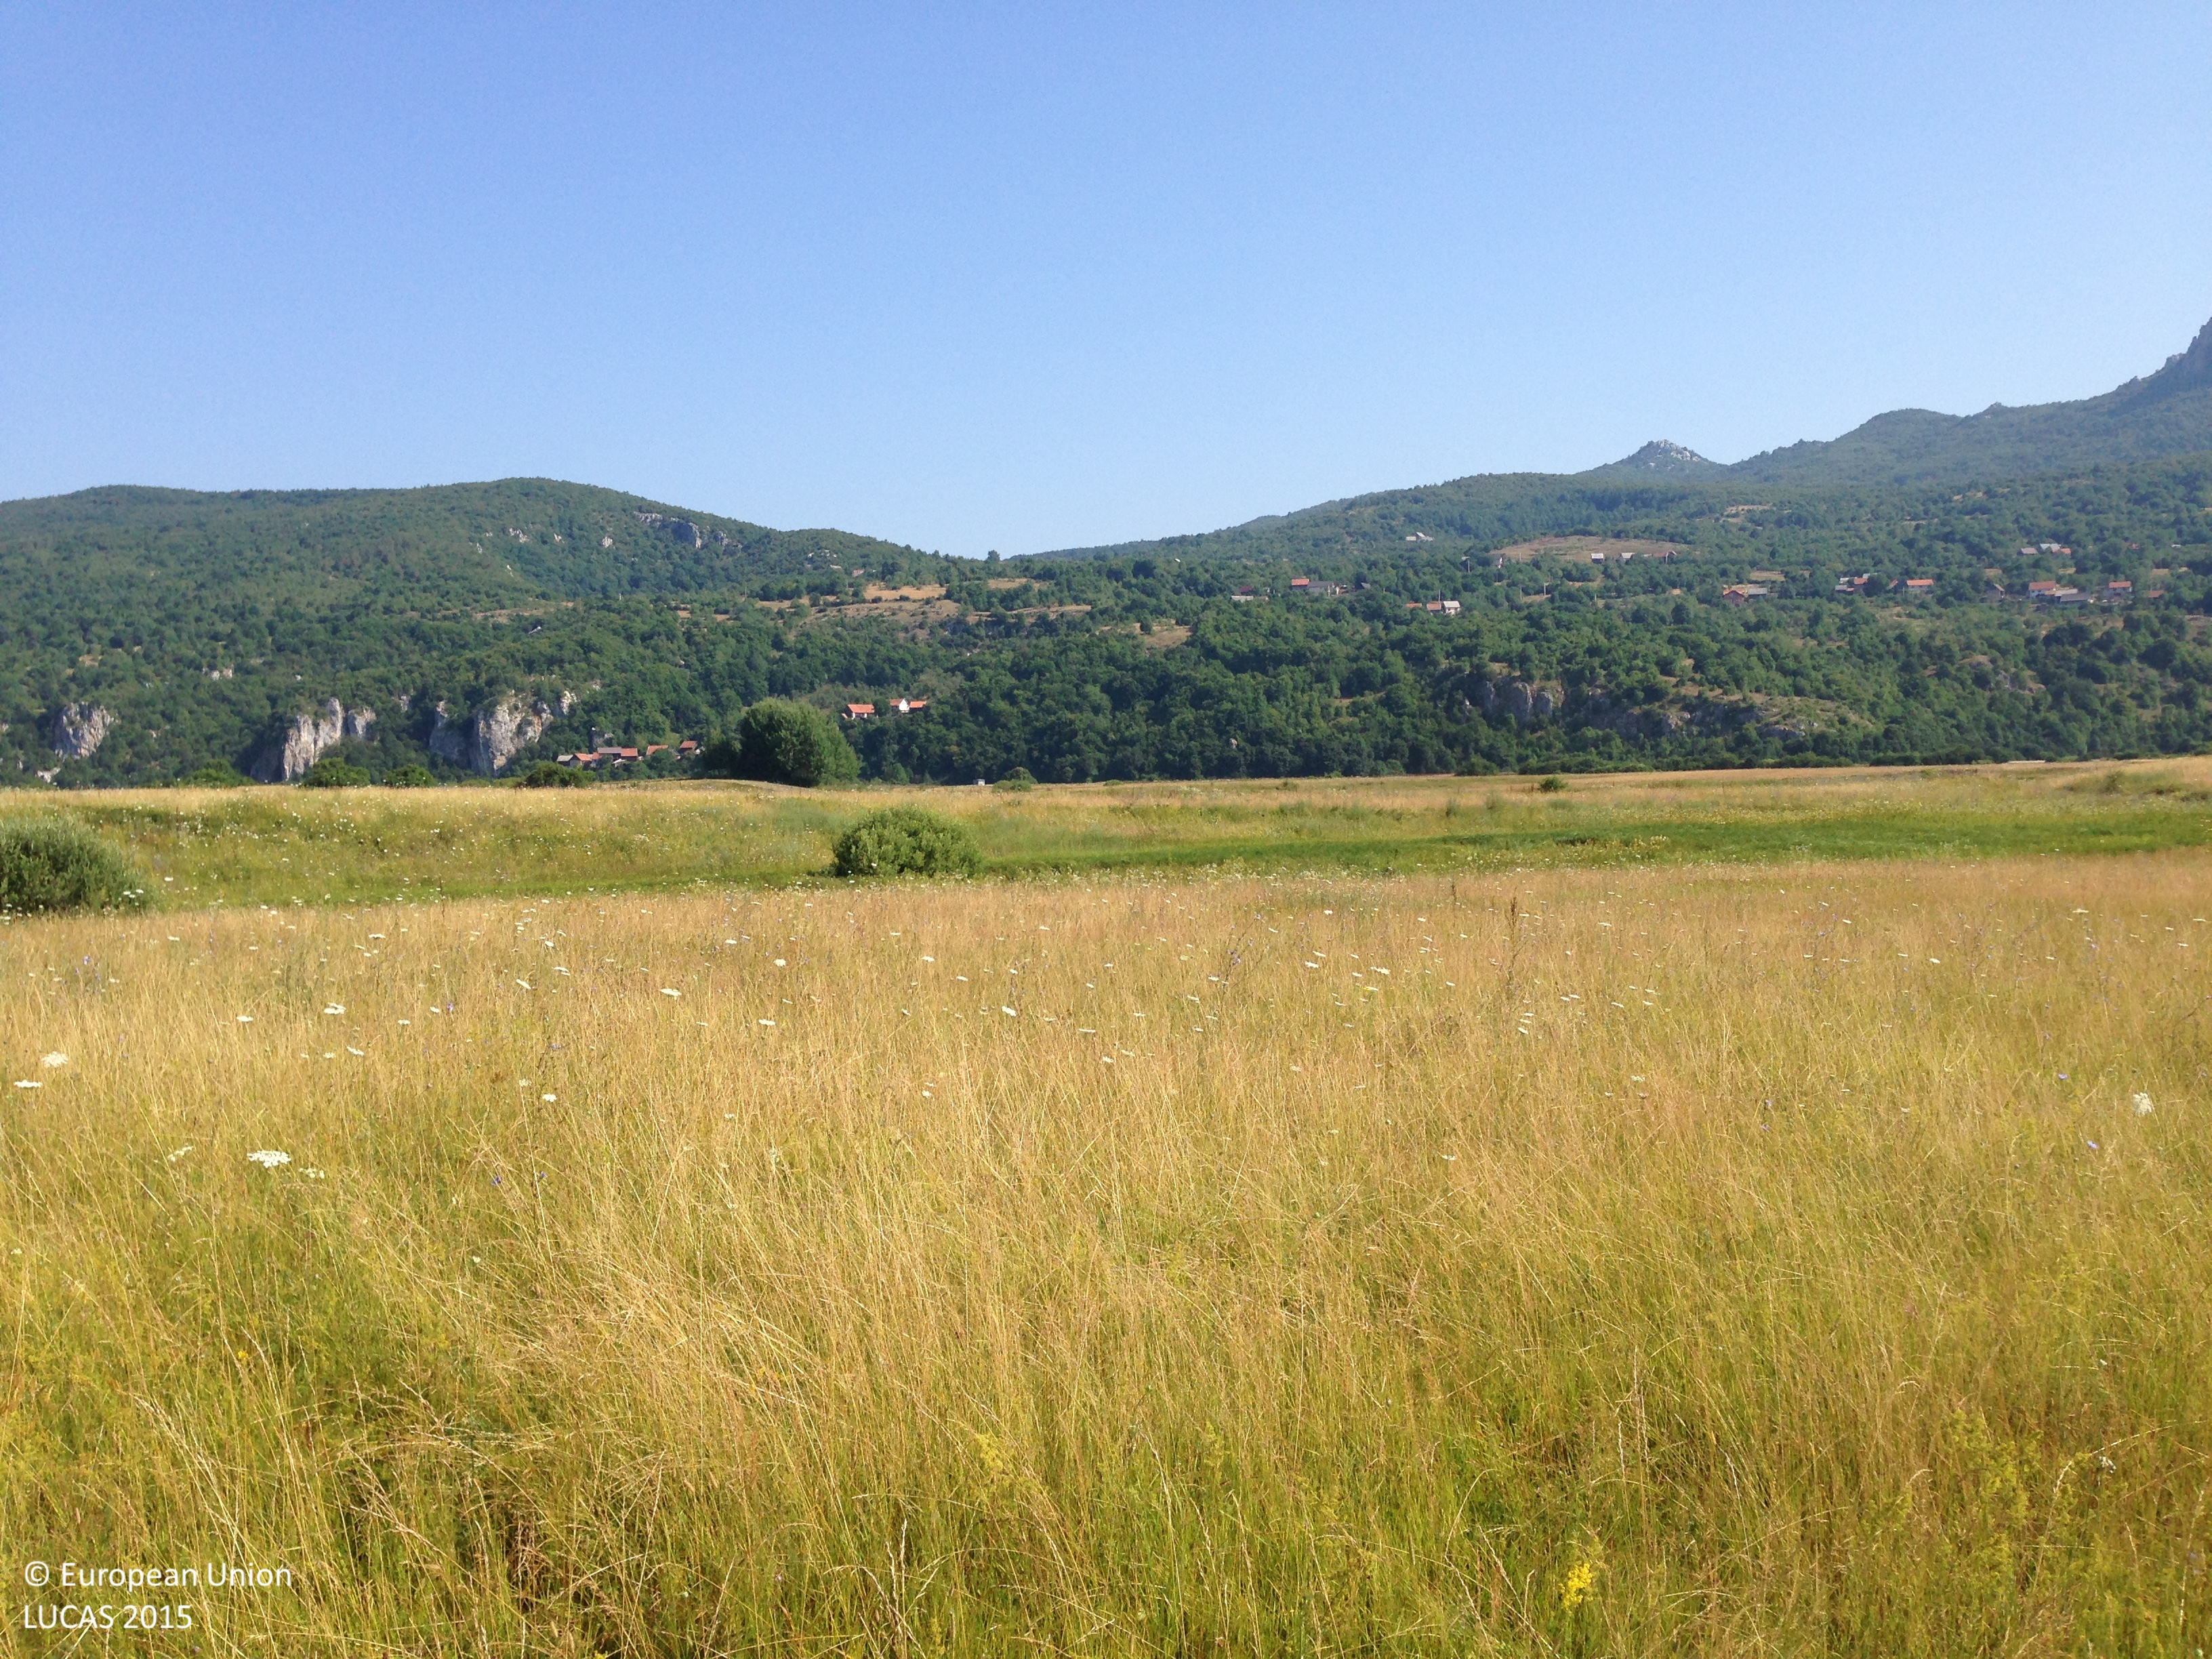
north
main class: Grassland
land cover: Grassland without tree/shrub cover
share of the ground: > 75 %
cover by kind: herbaceous plants 95 %, shrubs 5 %
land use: Agriculture (excluding fallow land and kitchen gardens)
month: July
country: HR
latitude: 44.7629
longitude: 15.1864
